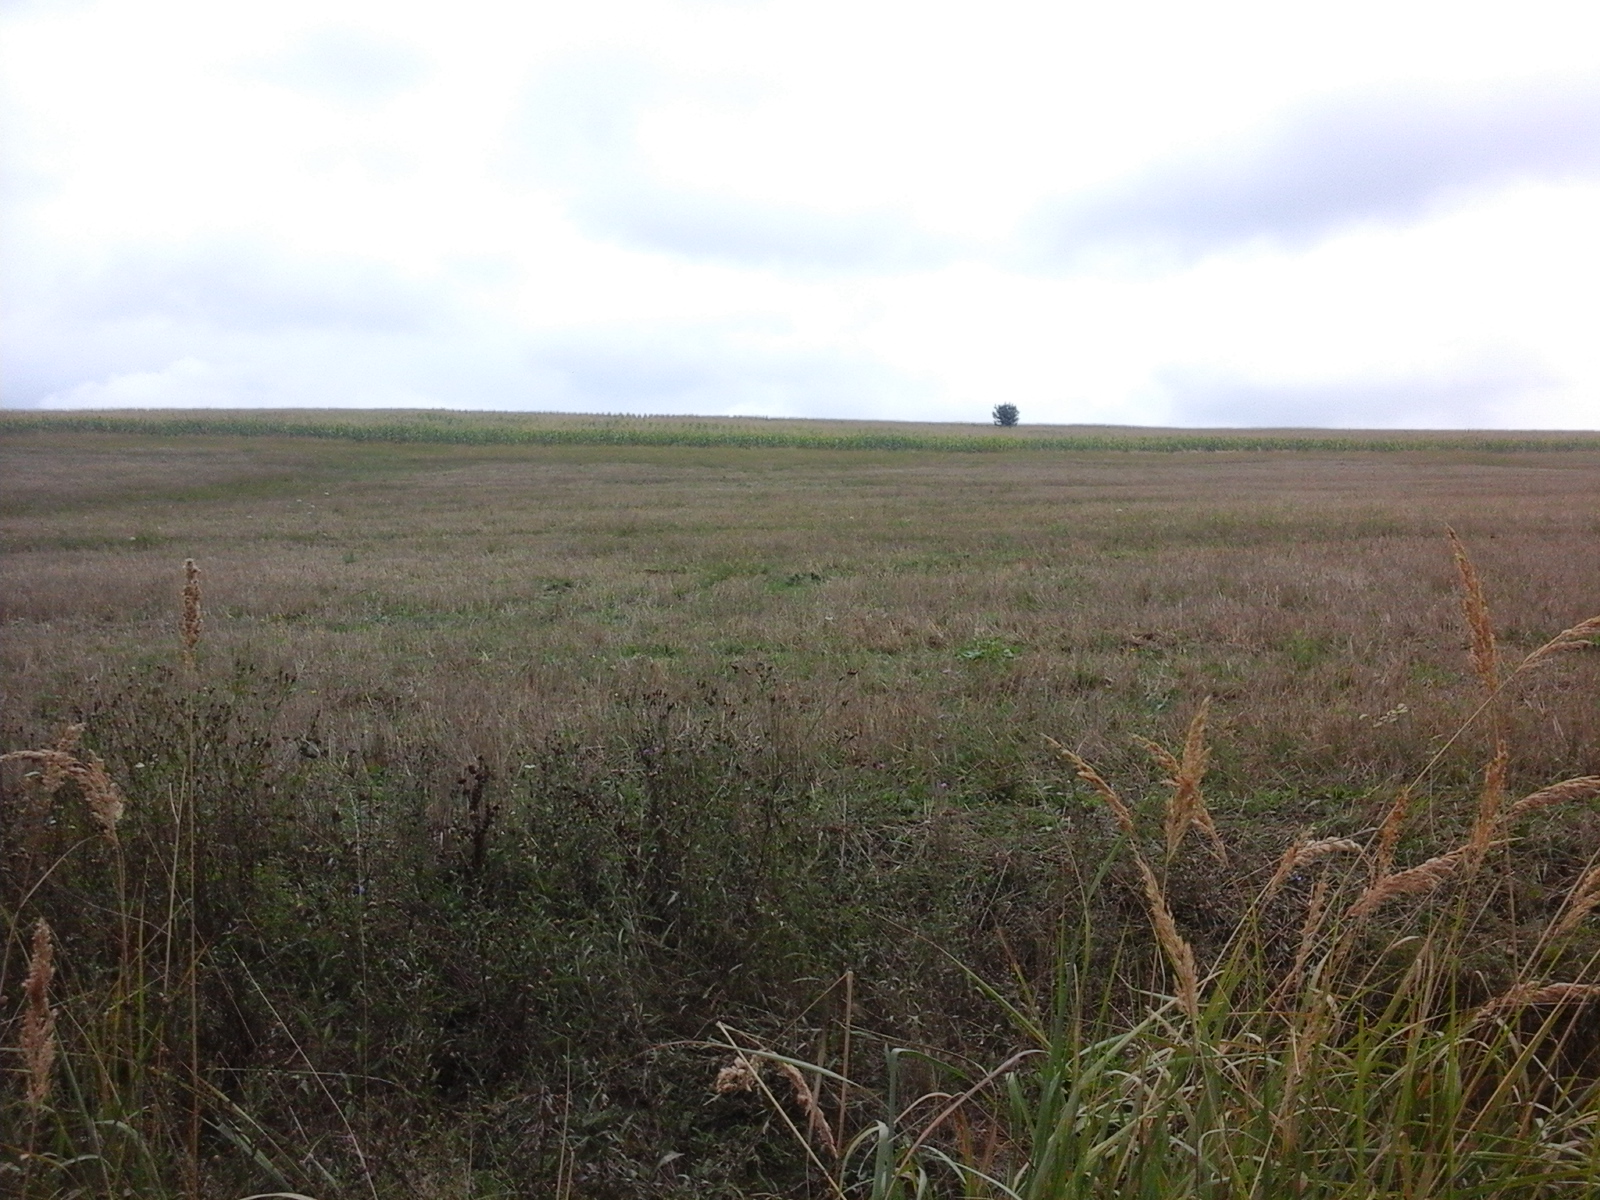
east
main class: Shrubland
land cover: Shrubland without tree cover
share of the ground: > 75 %
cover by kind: shrubs 100 %
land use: Semi-natural and natural areas not in use
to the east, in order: Shrubland without tree cover; Common wheat; Grass margins; Tracks; Grass margins; Maize
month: September
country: RO
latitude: 46.9747
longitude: 22.0756
